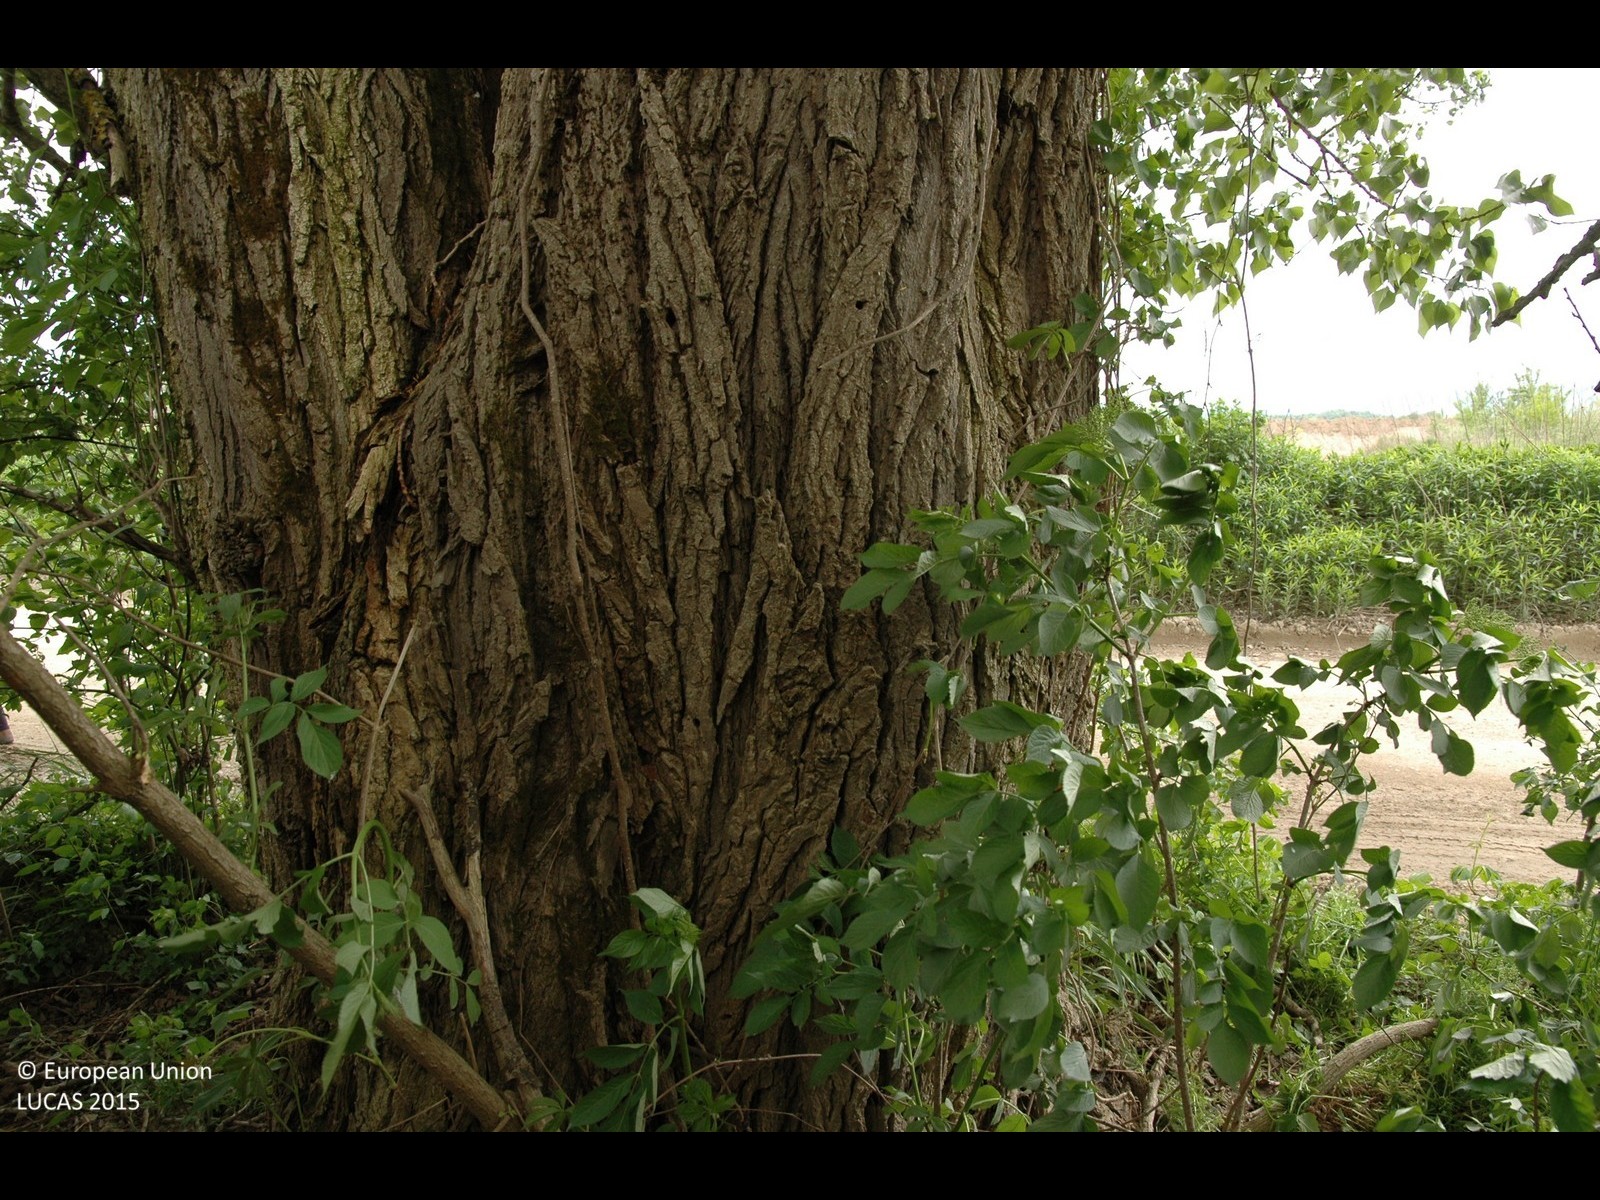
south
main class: Woodland
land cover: Broadleaved woodland
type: floodplain forest
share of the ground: > 75 %
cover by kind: broadleaved forest trees 80 %, shrubs 10 %, herbaceous plants 10 %
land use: Forestry
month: May
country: HR
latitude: 45.8353
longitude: 15.7523
